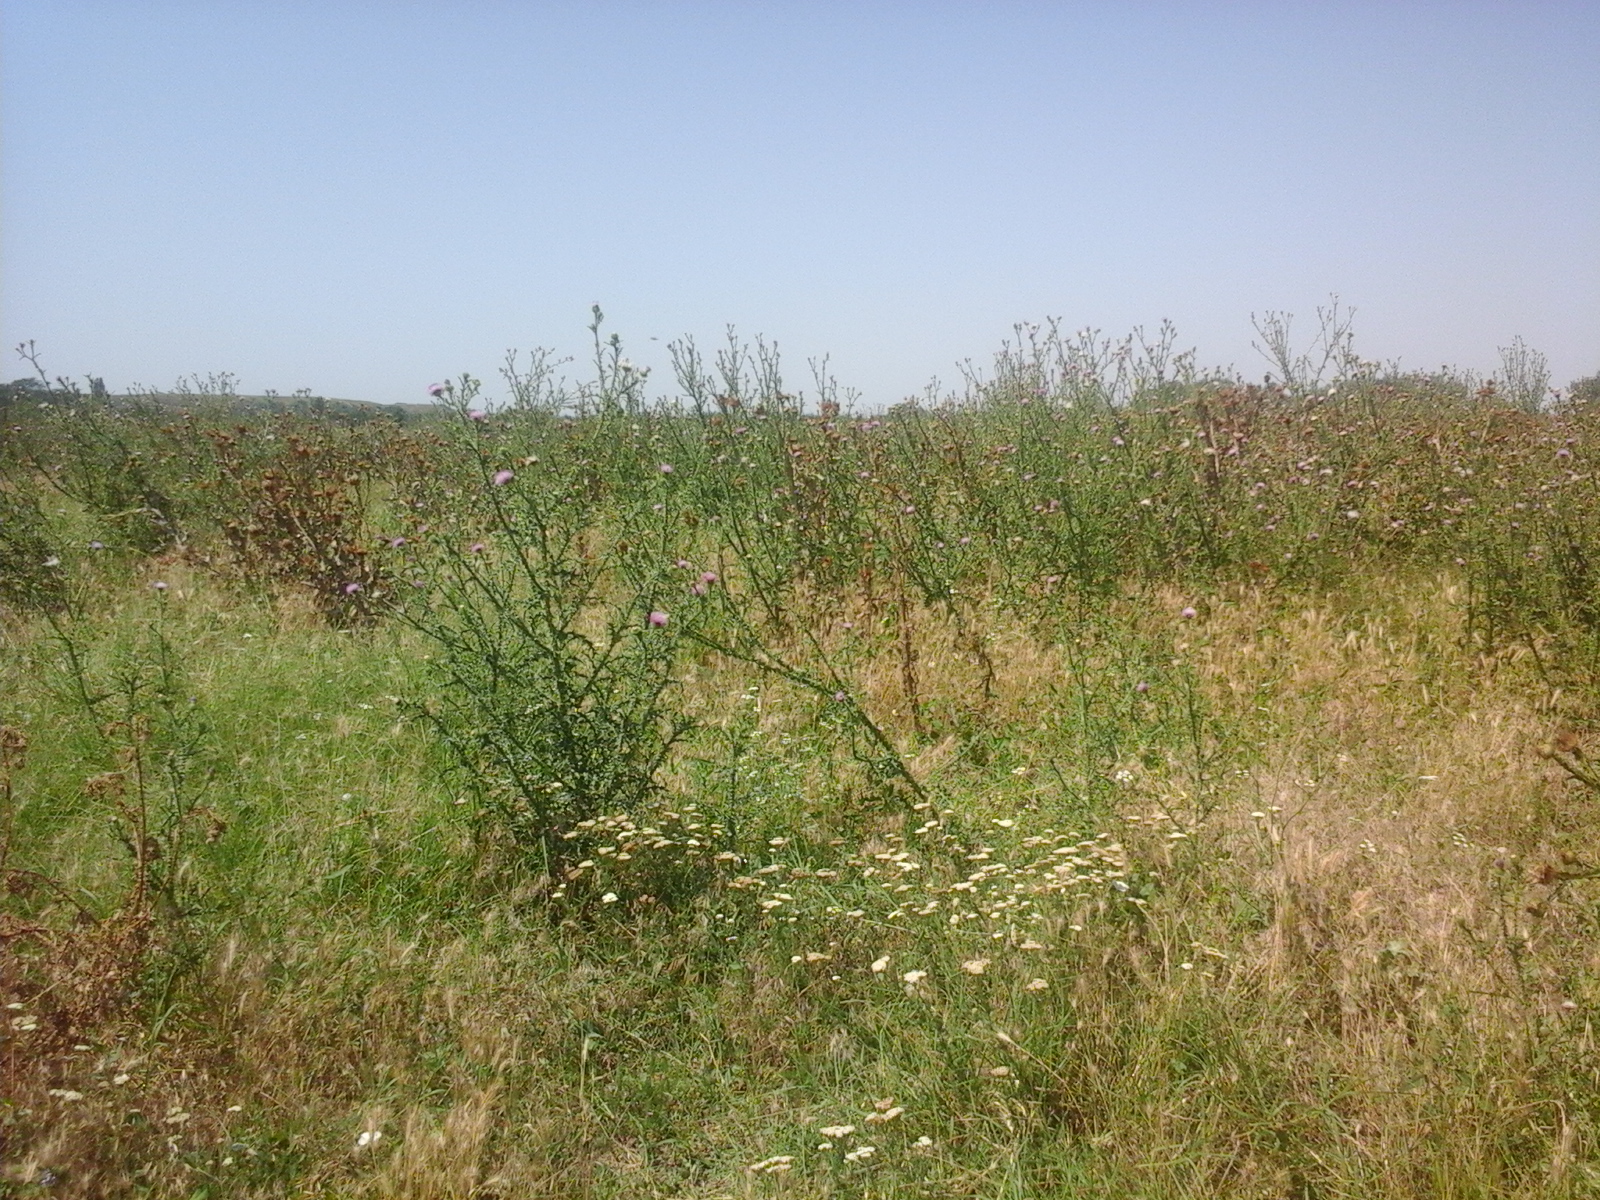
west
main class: Grassland
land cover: Spontaneously vegetated surfaces
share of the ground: > 75 %
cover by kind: herbaceous plants 100 %
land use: Fallow land
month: July
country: RO
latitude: 44.5507
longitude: 27.2431
